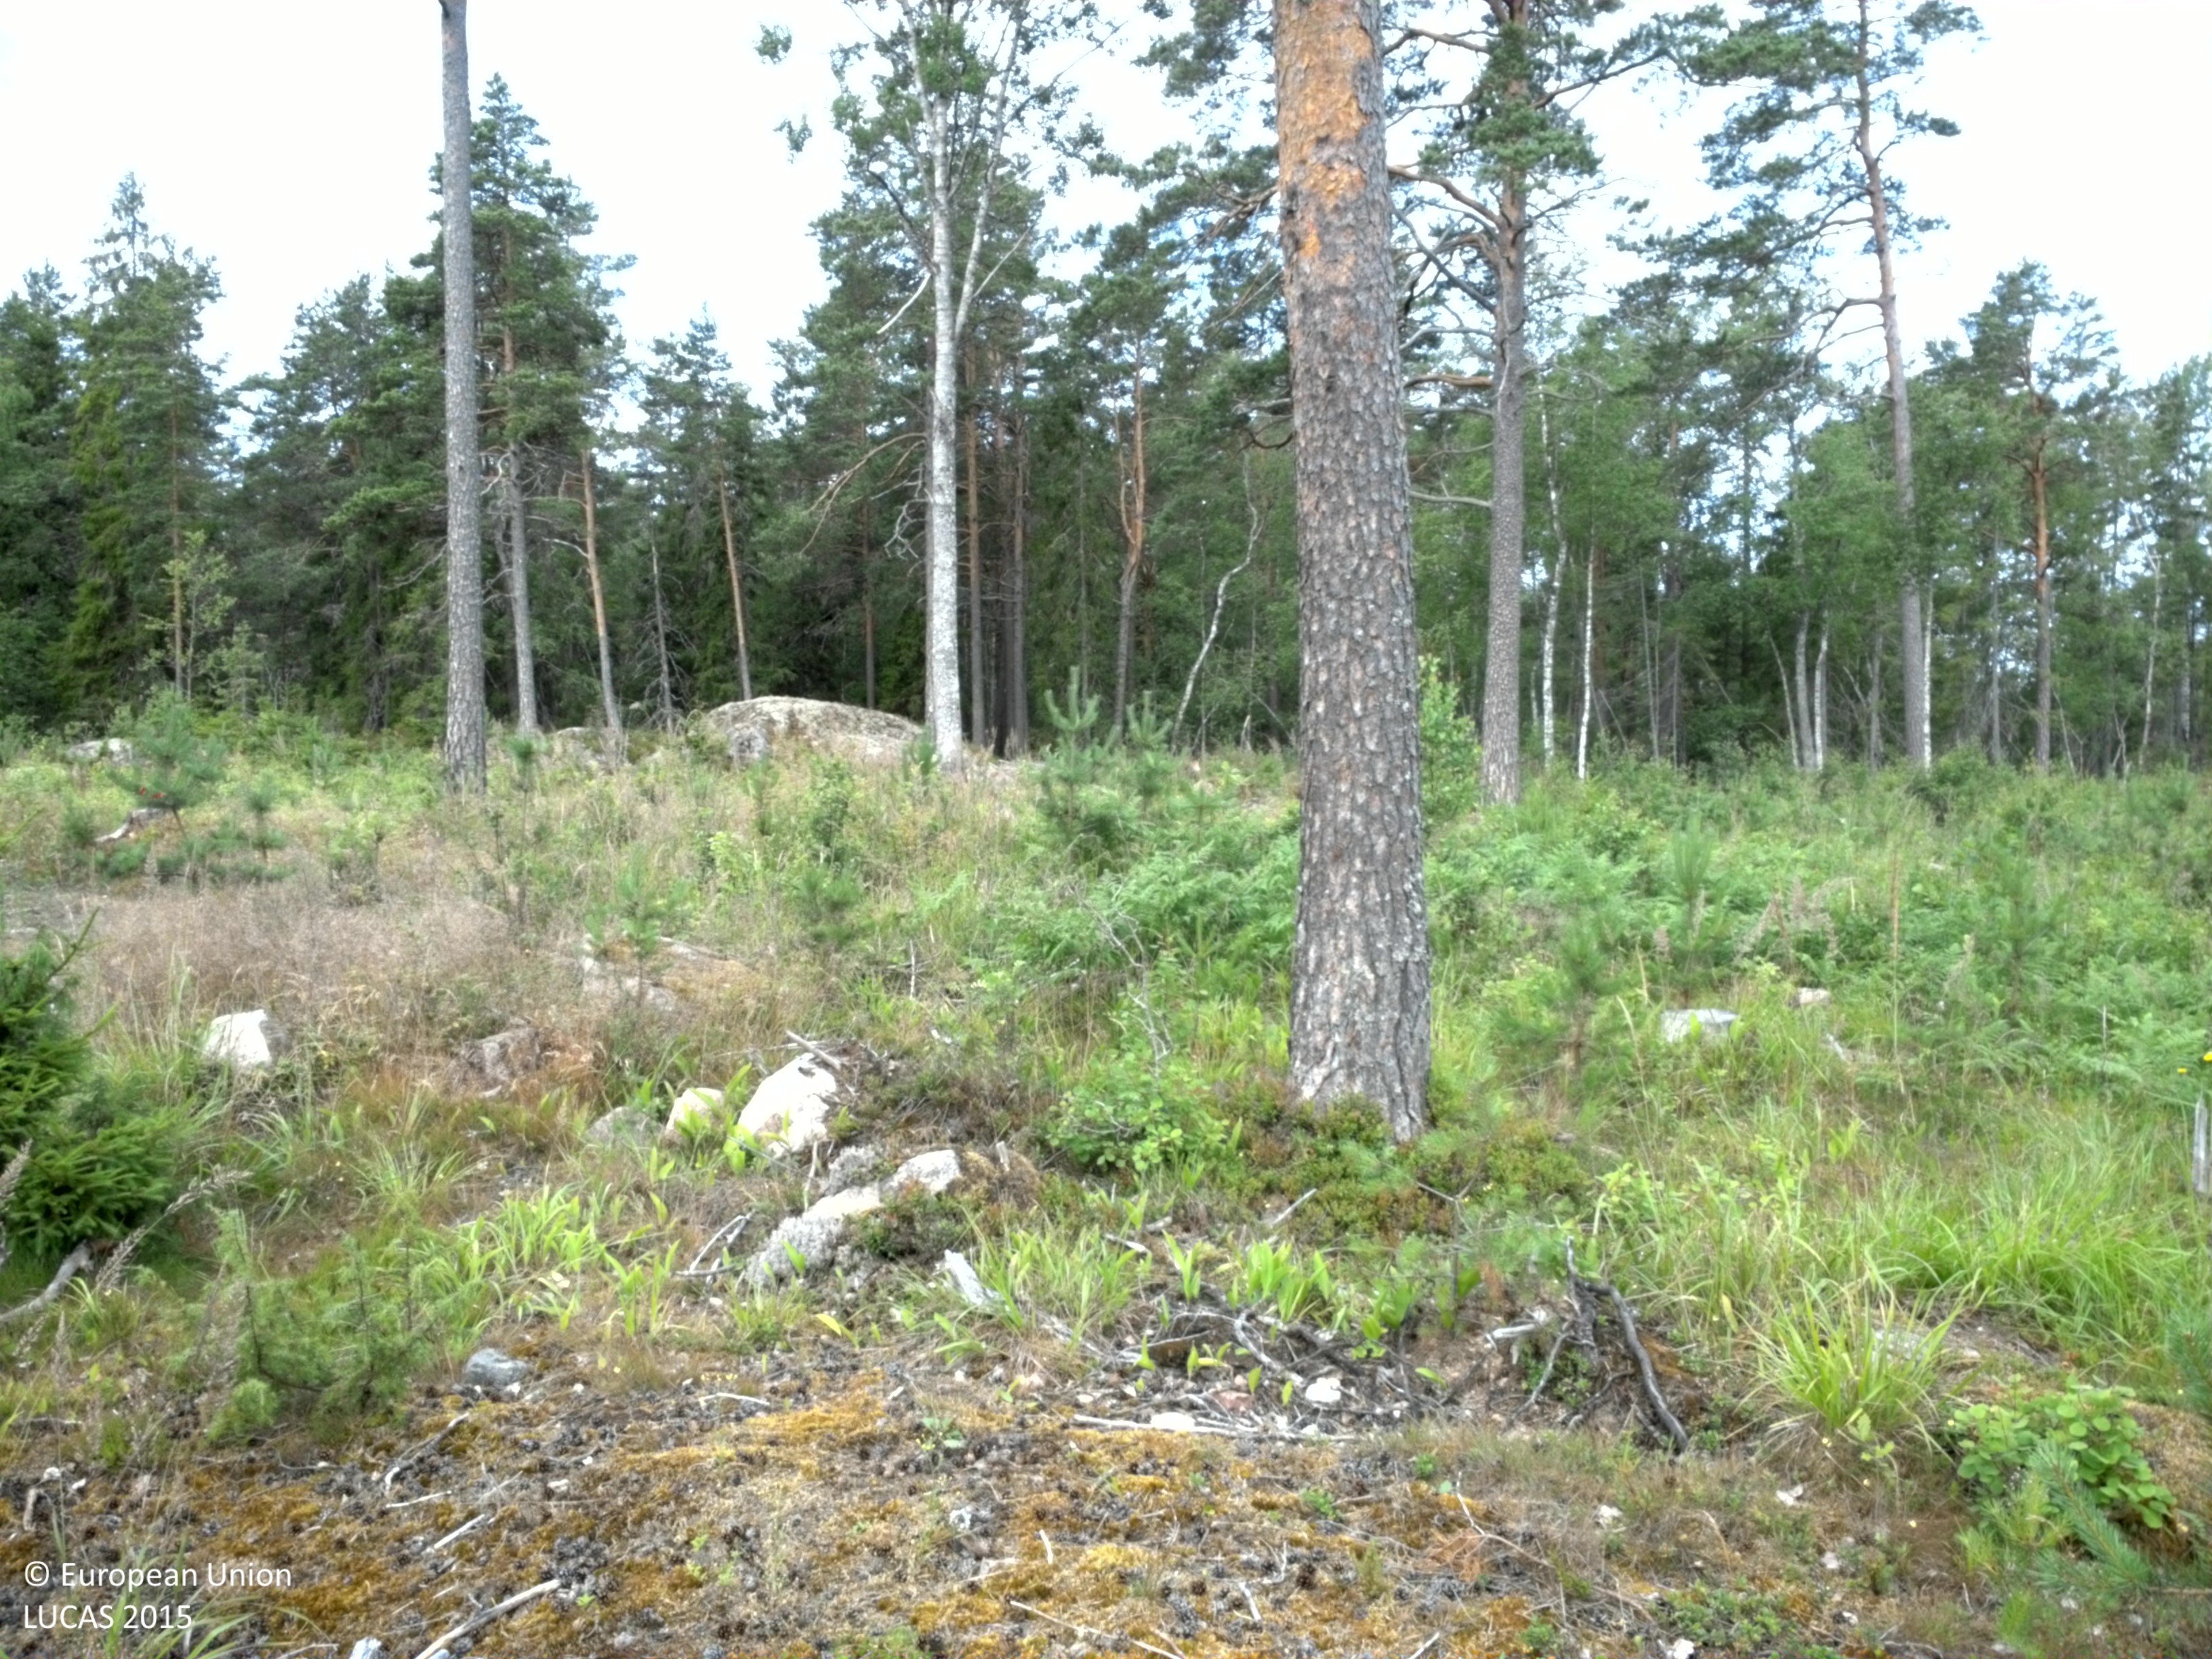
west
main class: Woodland
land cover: Pine dominated mixed woodland
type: boreal forest
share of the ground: 25 - 50 %
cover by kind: herbaceous plants 45 %, coniferous forest trees 30 %, lichens and mosses 15 %, broadleaved forest trees 10 %
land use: Forestry
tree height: < 5 m
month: July
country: SE
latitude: 60.0204
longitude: 18.7001
